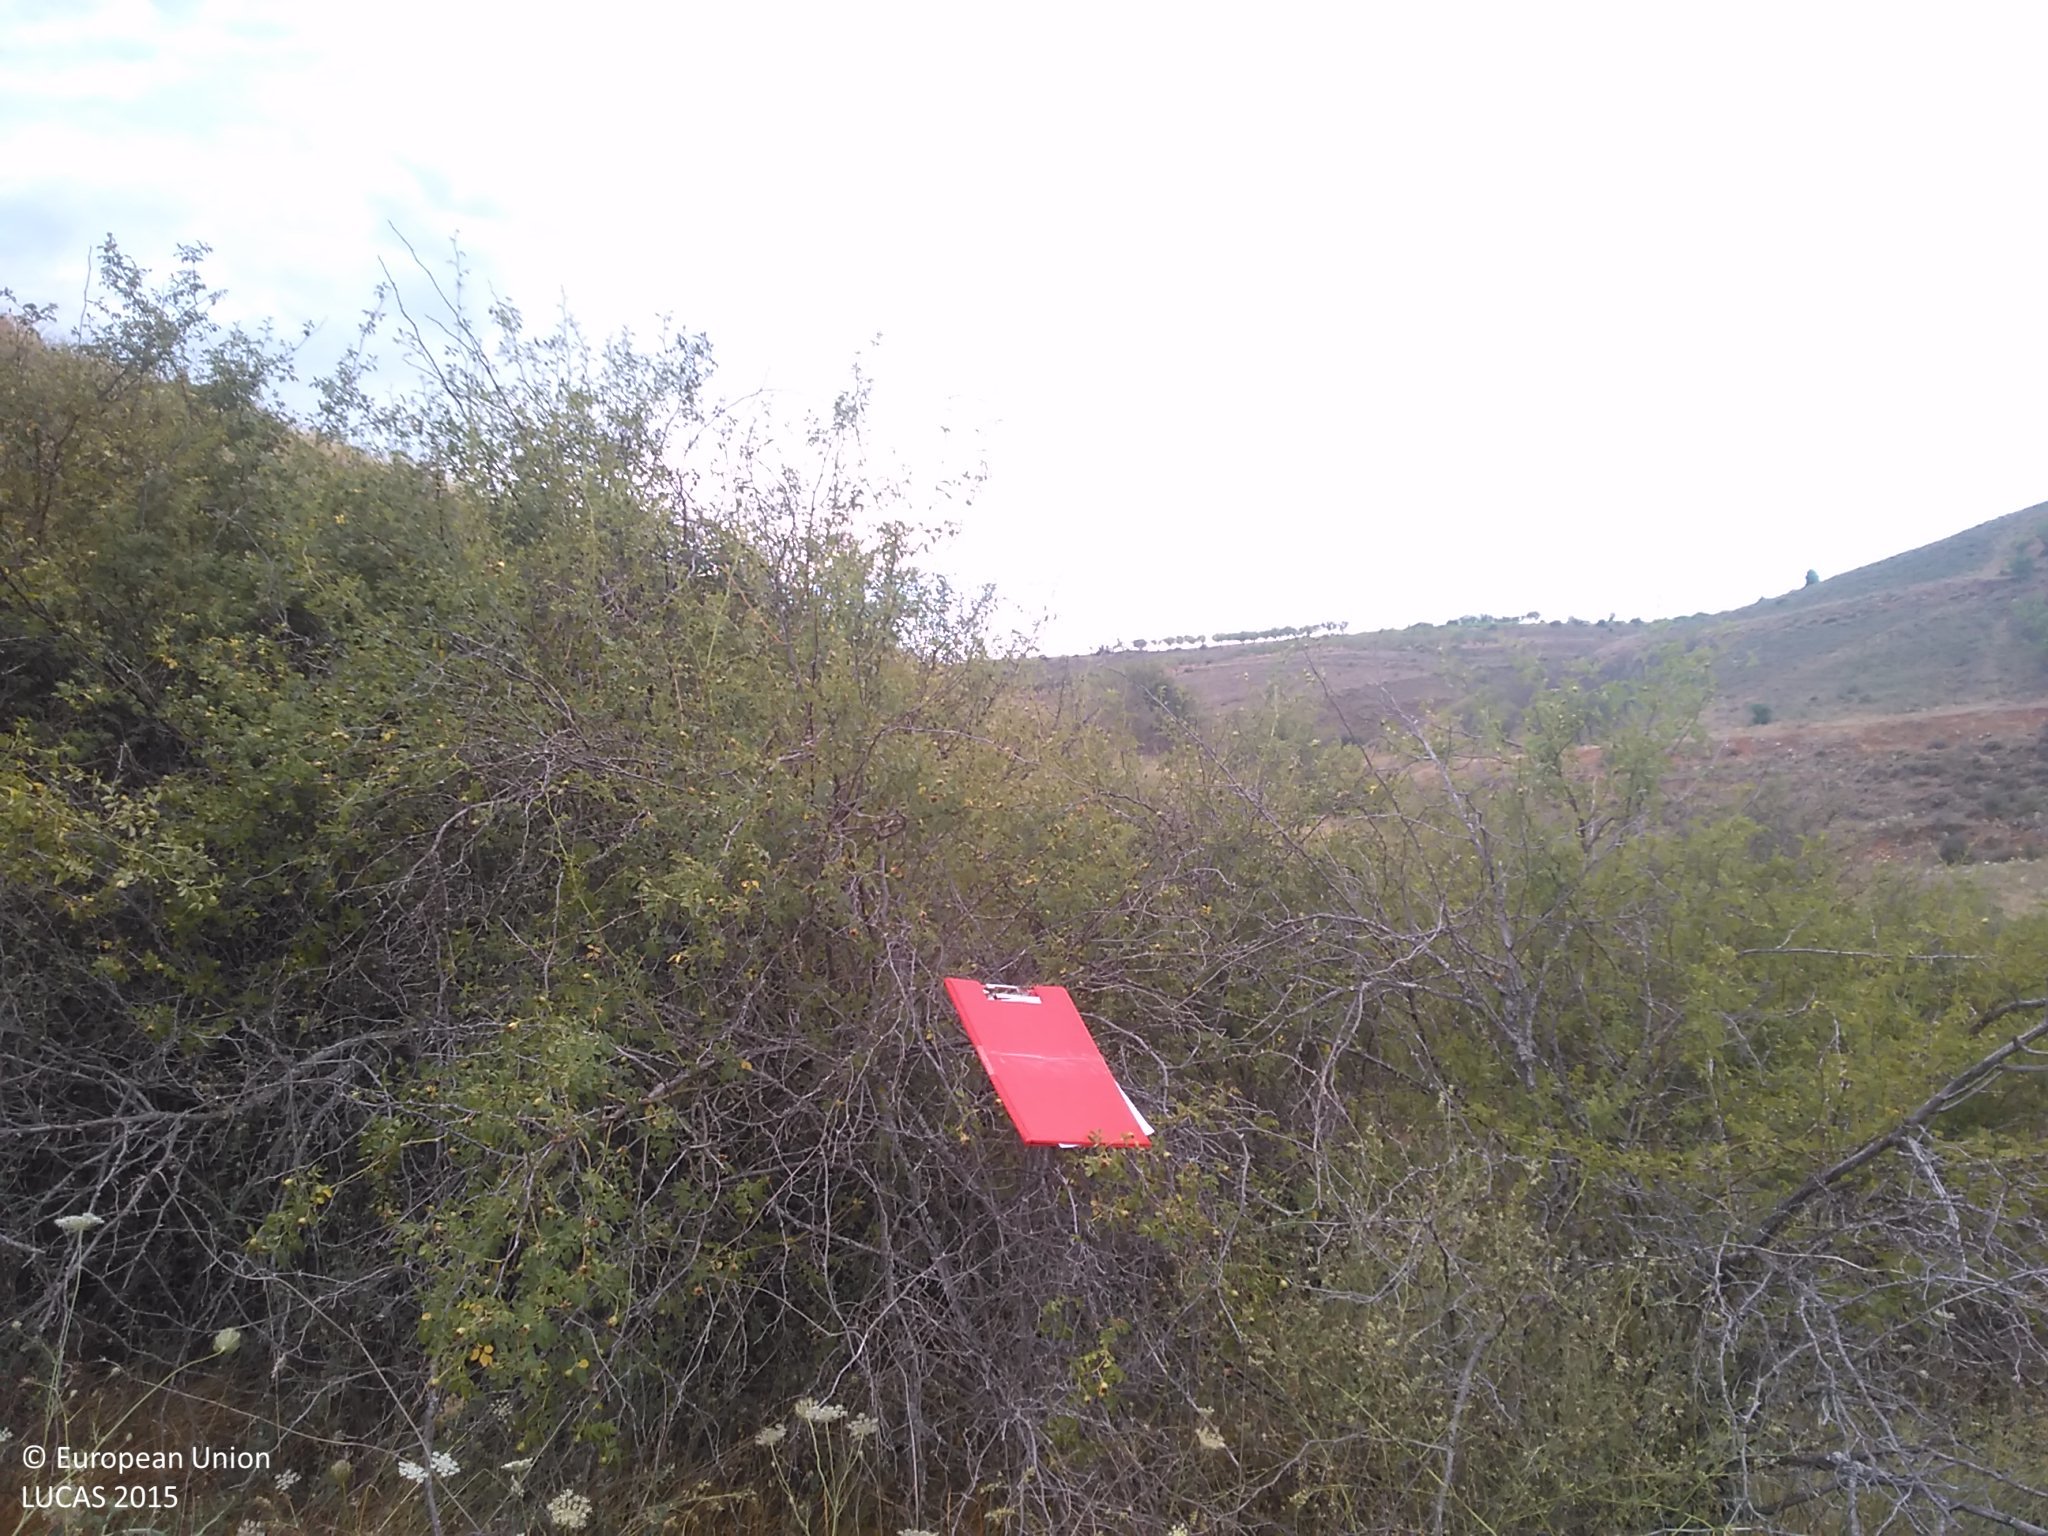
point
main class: Shrubland
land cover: Shrubland without tree cover
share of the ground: 50 - 75 %
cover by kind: shrubs 70 %, herbaceous plants 30 %
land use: Semi-natural and natural areas not in use
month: July
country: ES
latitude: 41.4290
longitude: -1.9837
